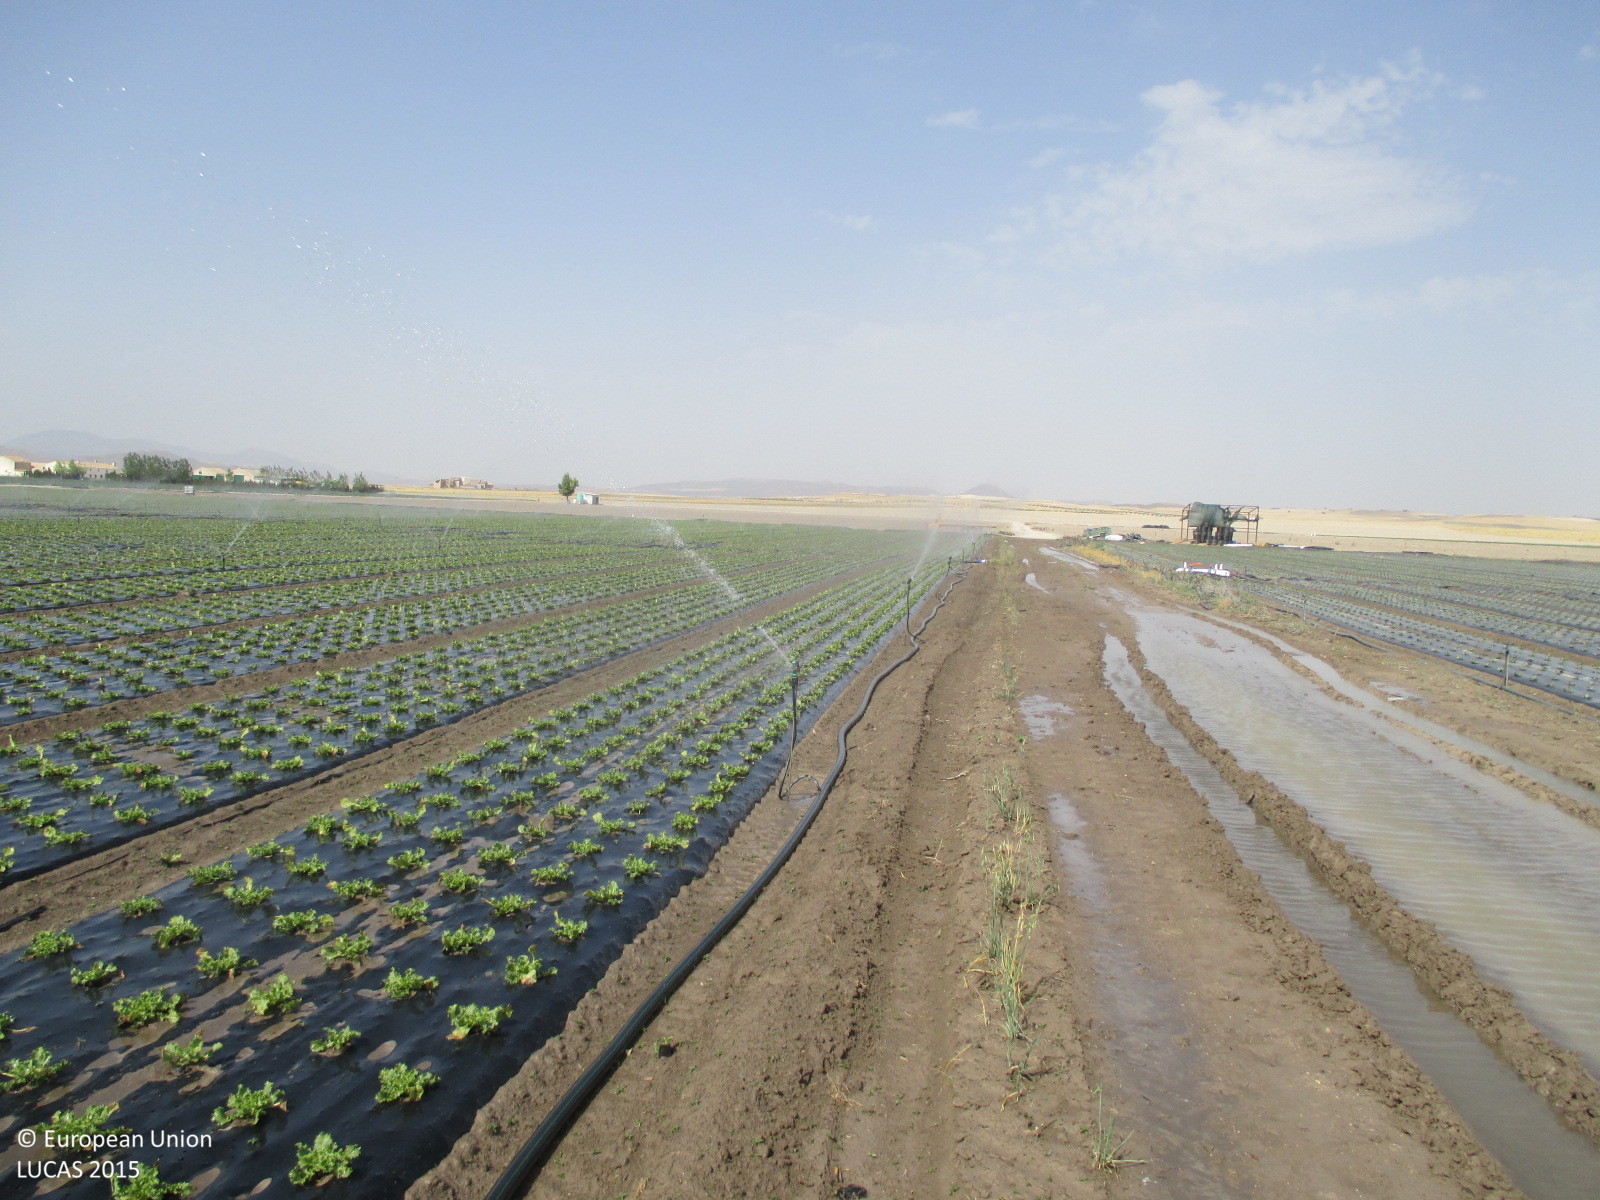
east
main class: Cropland
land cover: Other fresh vegetables
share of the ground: 10 - 25 %
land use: Agriculture (excluding fallow land and kitchen gardens)
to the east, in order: Other fresh vegetables; Tracks; Other fresh vegetables; Tracks; Other bare soil
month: July
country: ES
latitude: 37.8265
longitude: -2.4298
